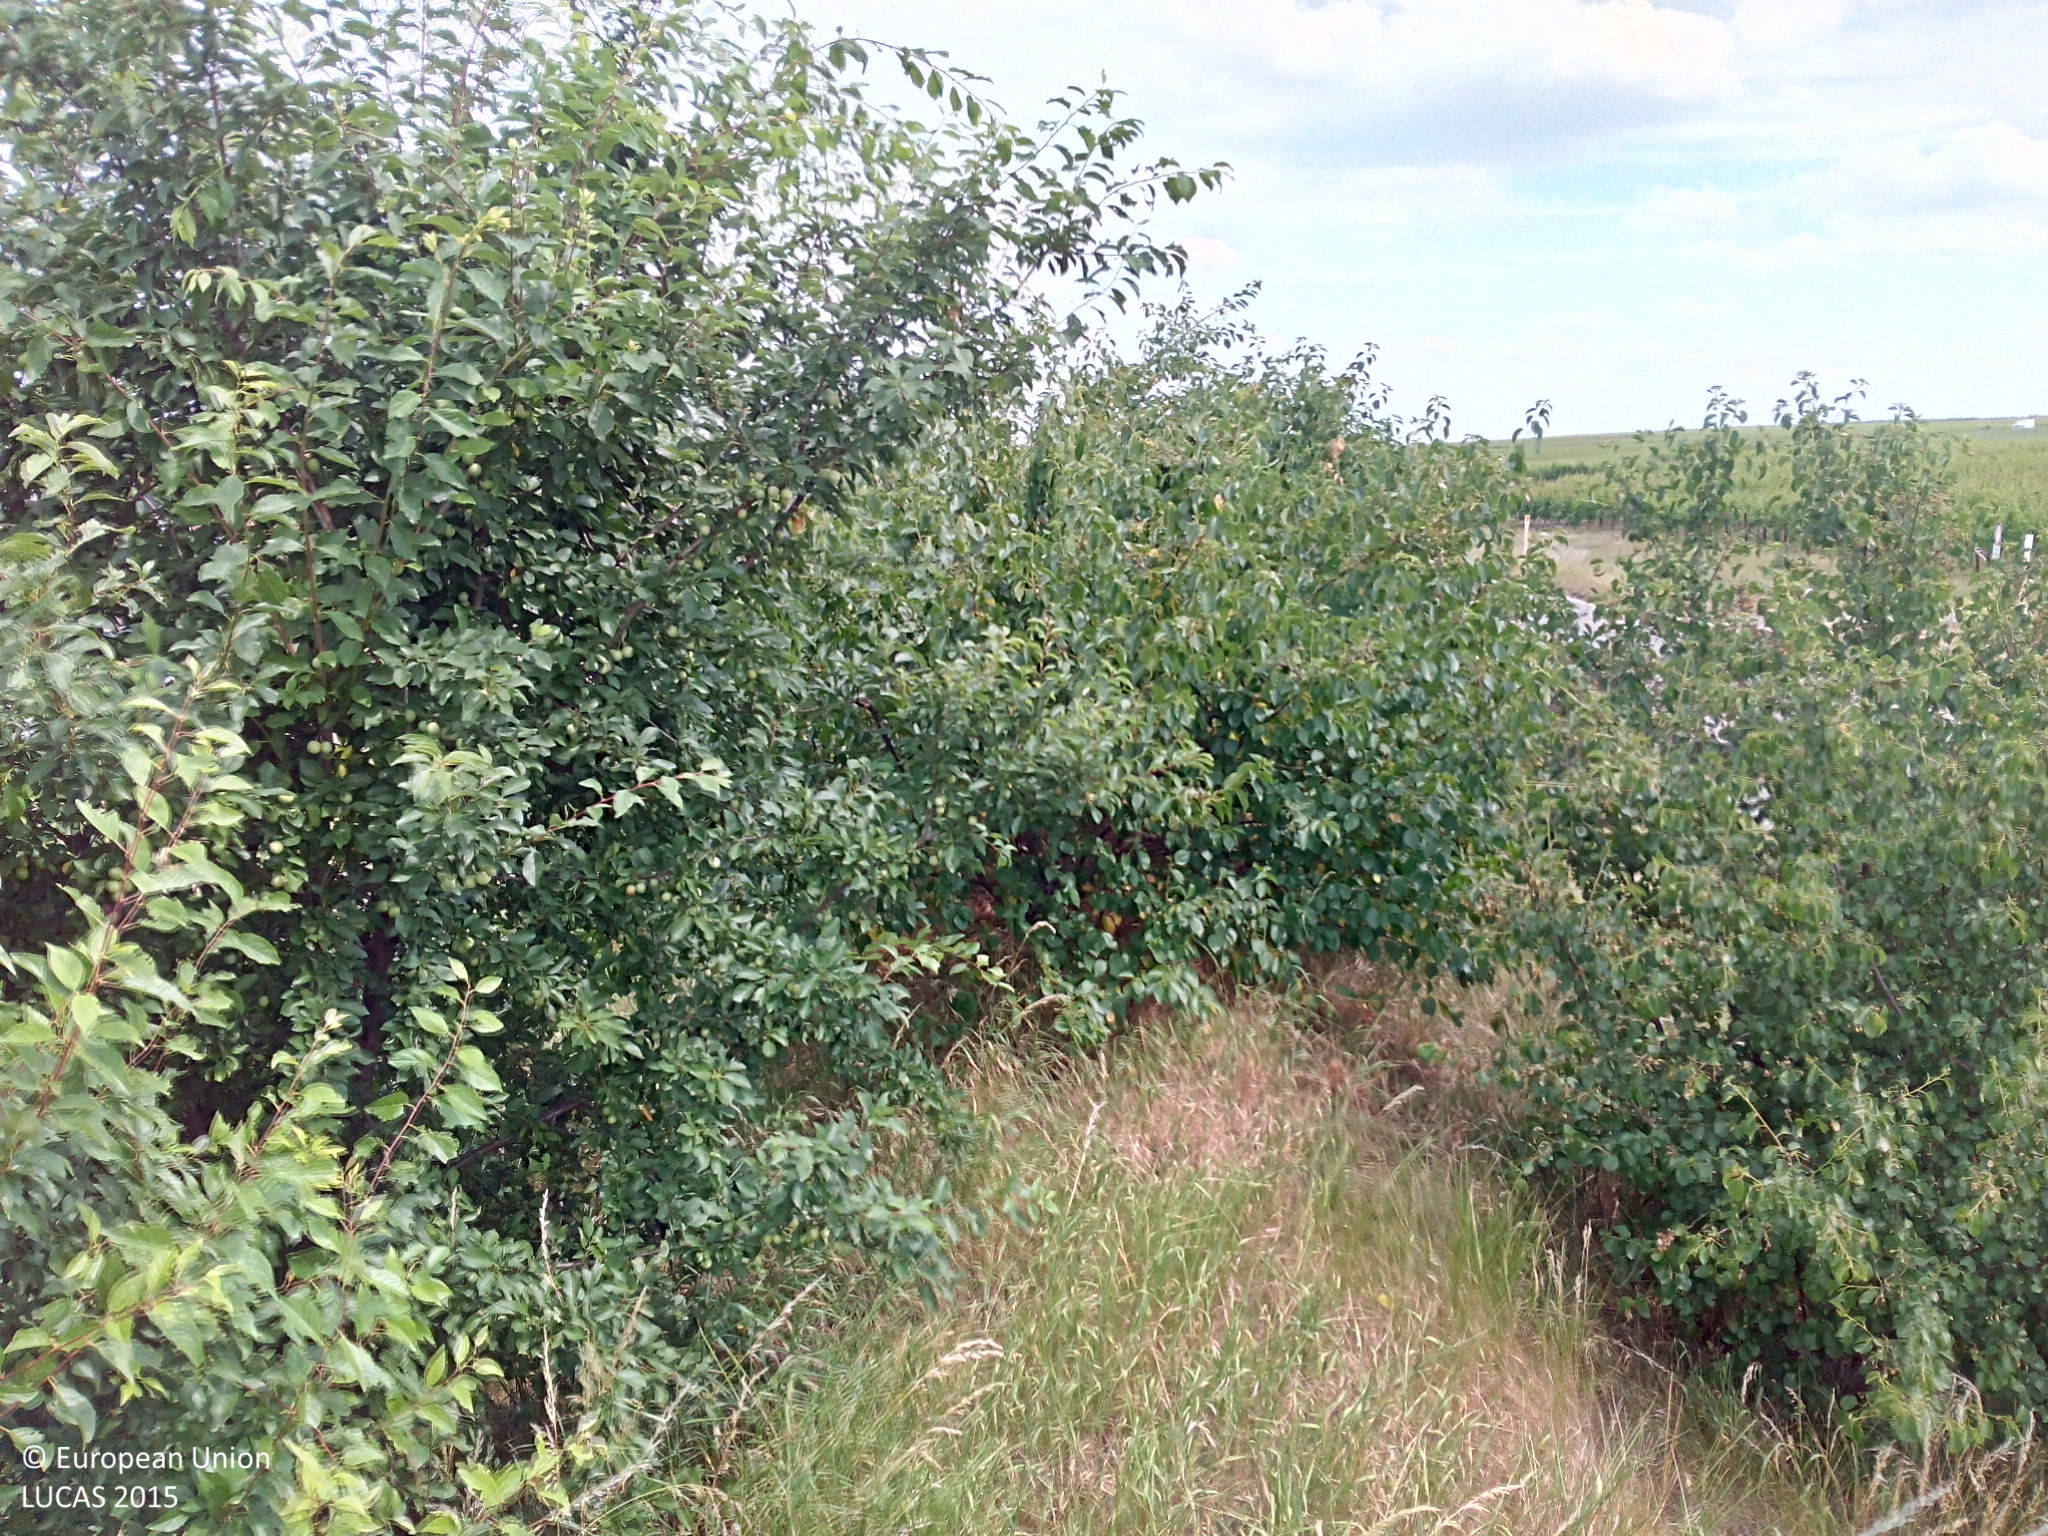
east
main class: Grassland
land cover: Grassland with sparse tree/shrub cover
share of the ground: > 75 %
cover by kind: herbaceous plants 65 %, unconsolidated bare surface 25 %, broadleaved forest trees 5 %, shrubs 5 %
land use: Residential
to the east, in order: Grassland with sparse tree/shrub cover; Broadleaved woodland; Artificial constructions in urban areas; Grass margins; Sugar beet; Grassland without tree/shrub cover; Vineyards; Spontaneously vegetated surfaces
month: June
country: DE
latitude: 49.5399
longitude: 8.1625
